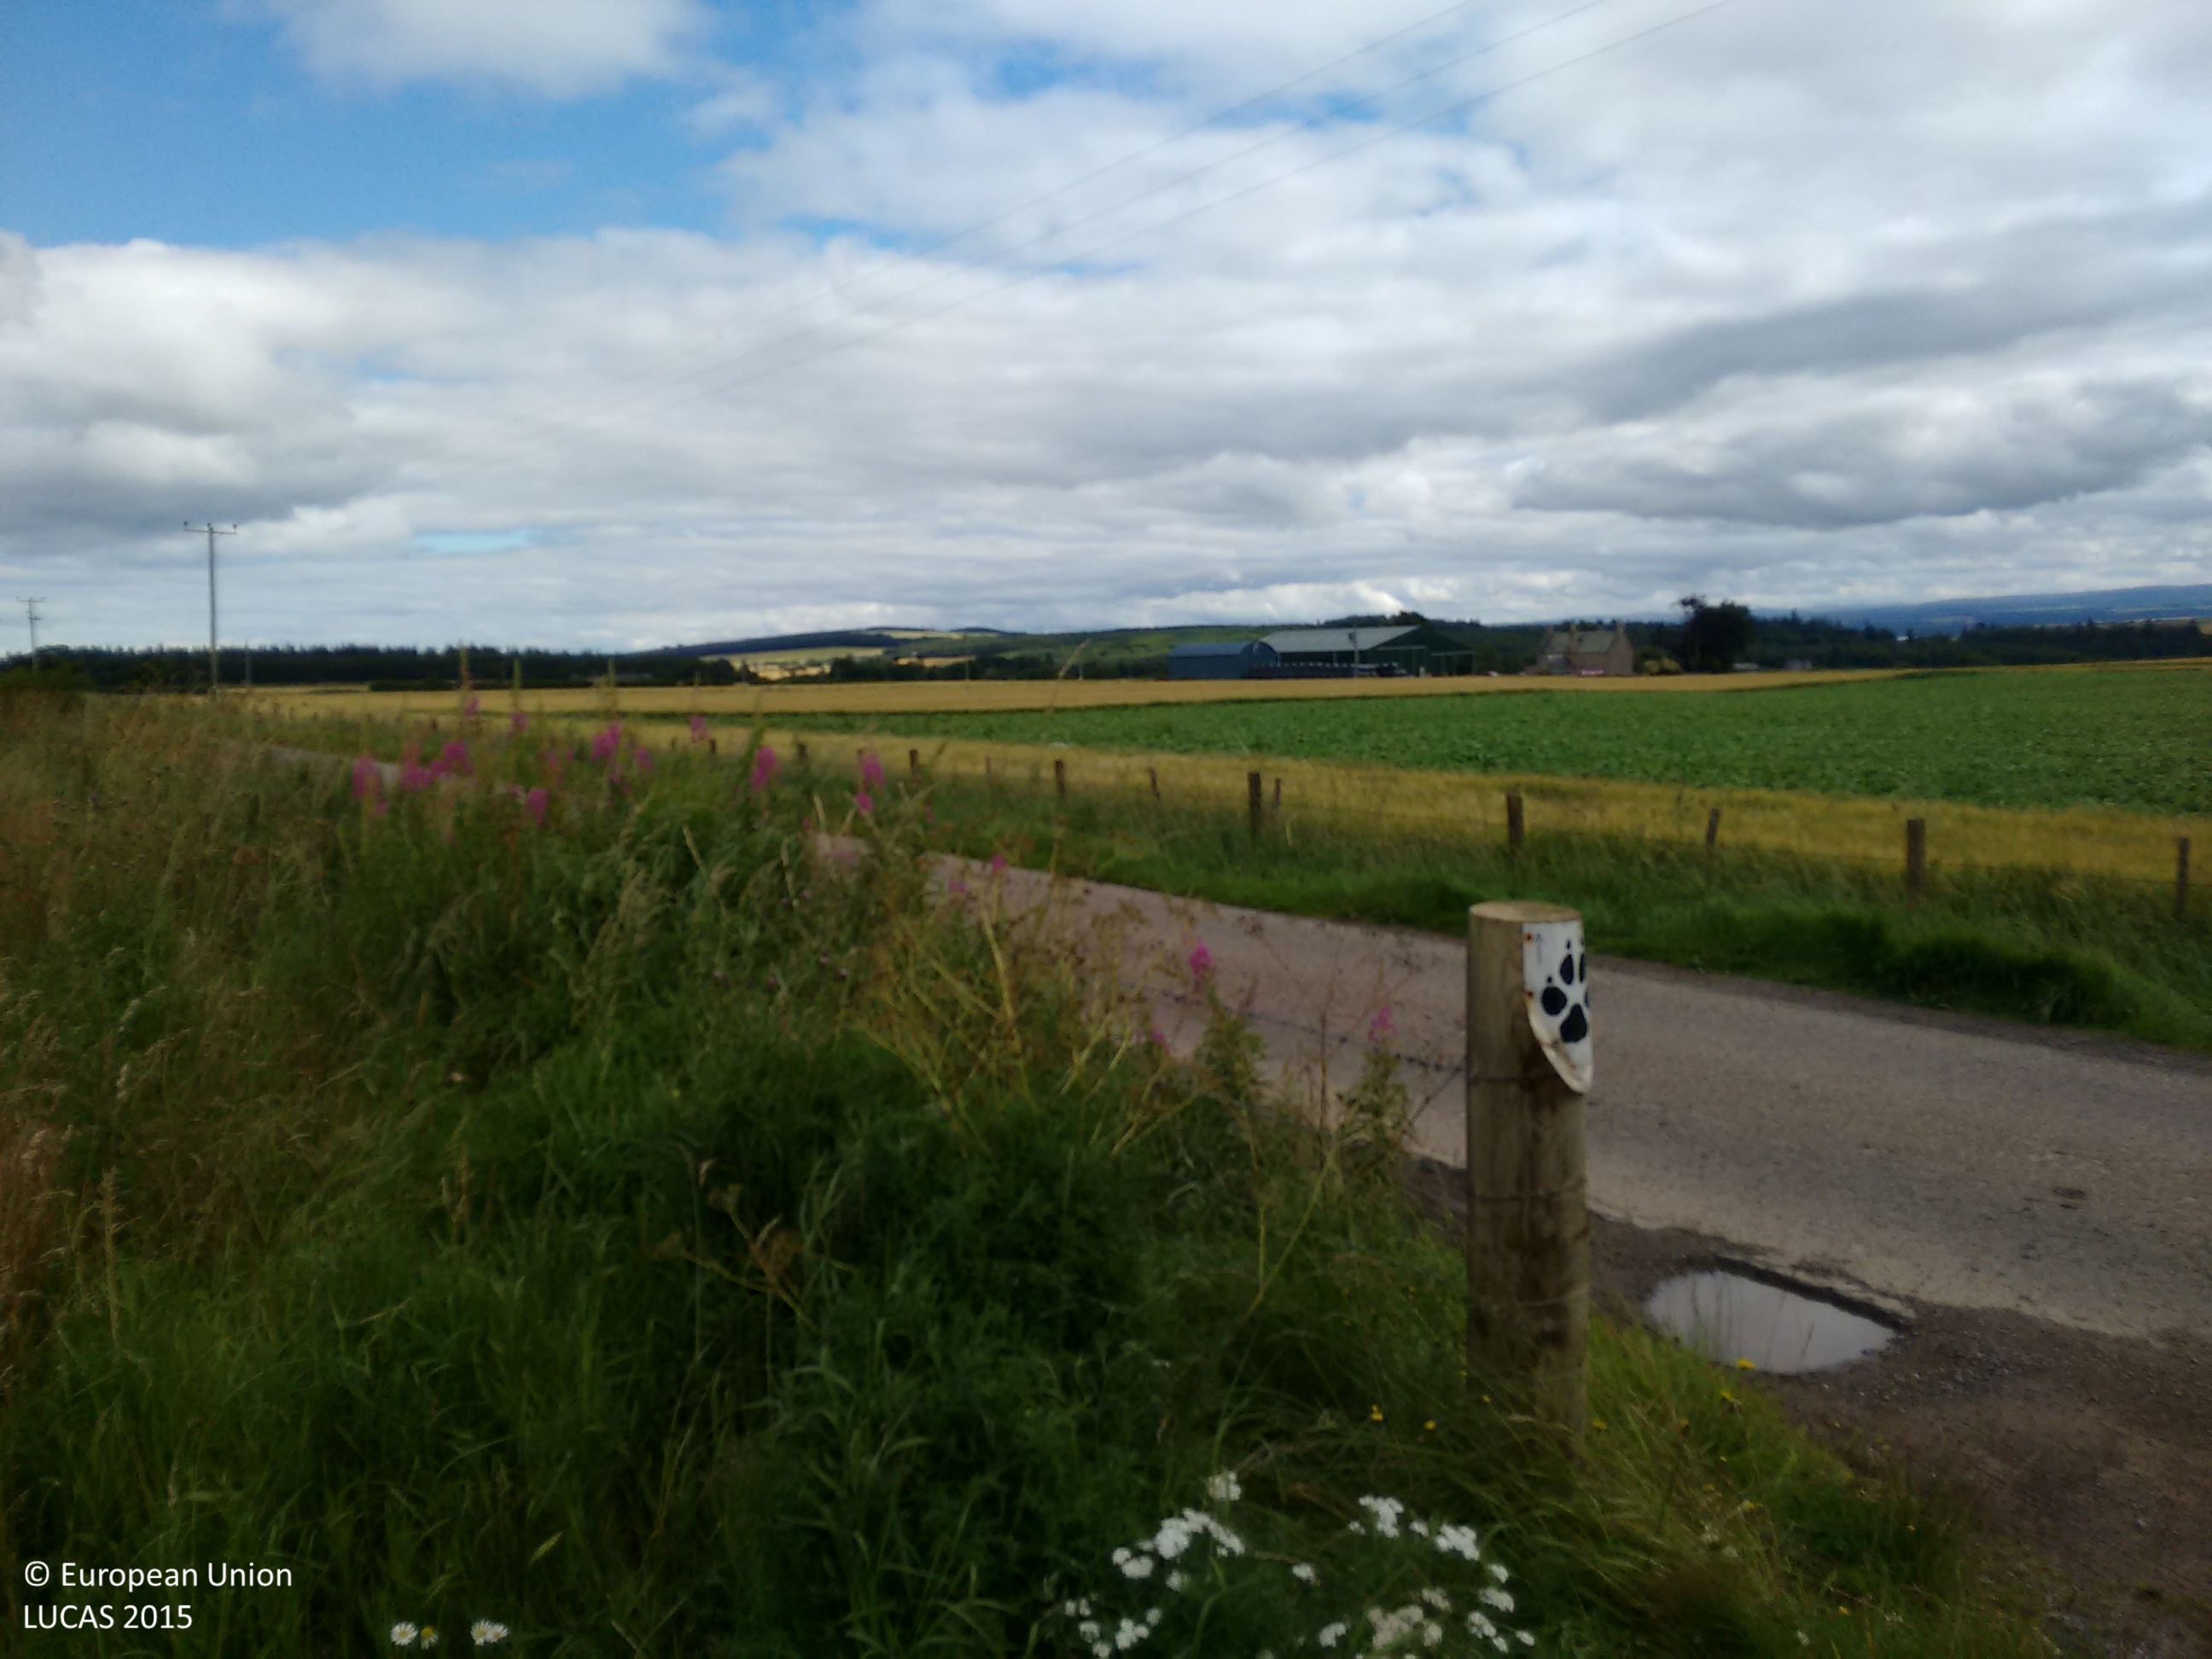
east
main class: Cropland
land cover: Potatoes
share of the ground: > 75 %
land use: Agriculture (excluding fallow land and kitchen gardens)
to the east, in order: Potatoes
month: August
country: GB
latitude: 57.5827
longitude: -4.2513
